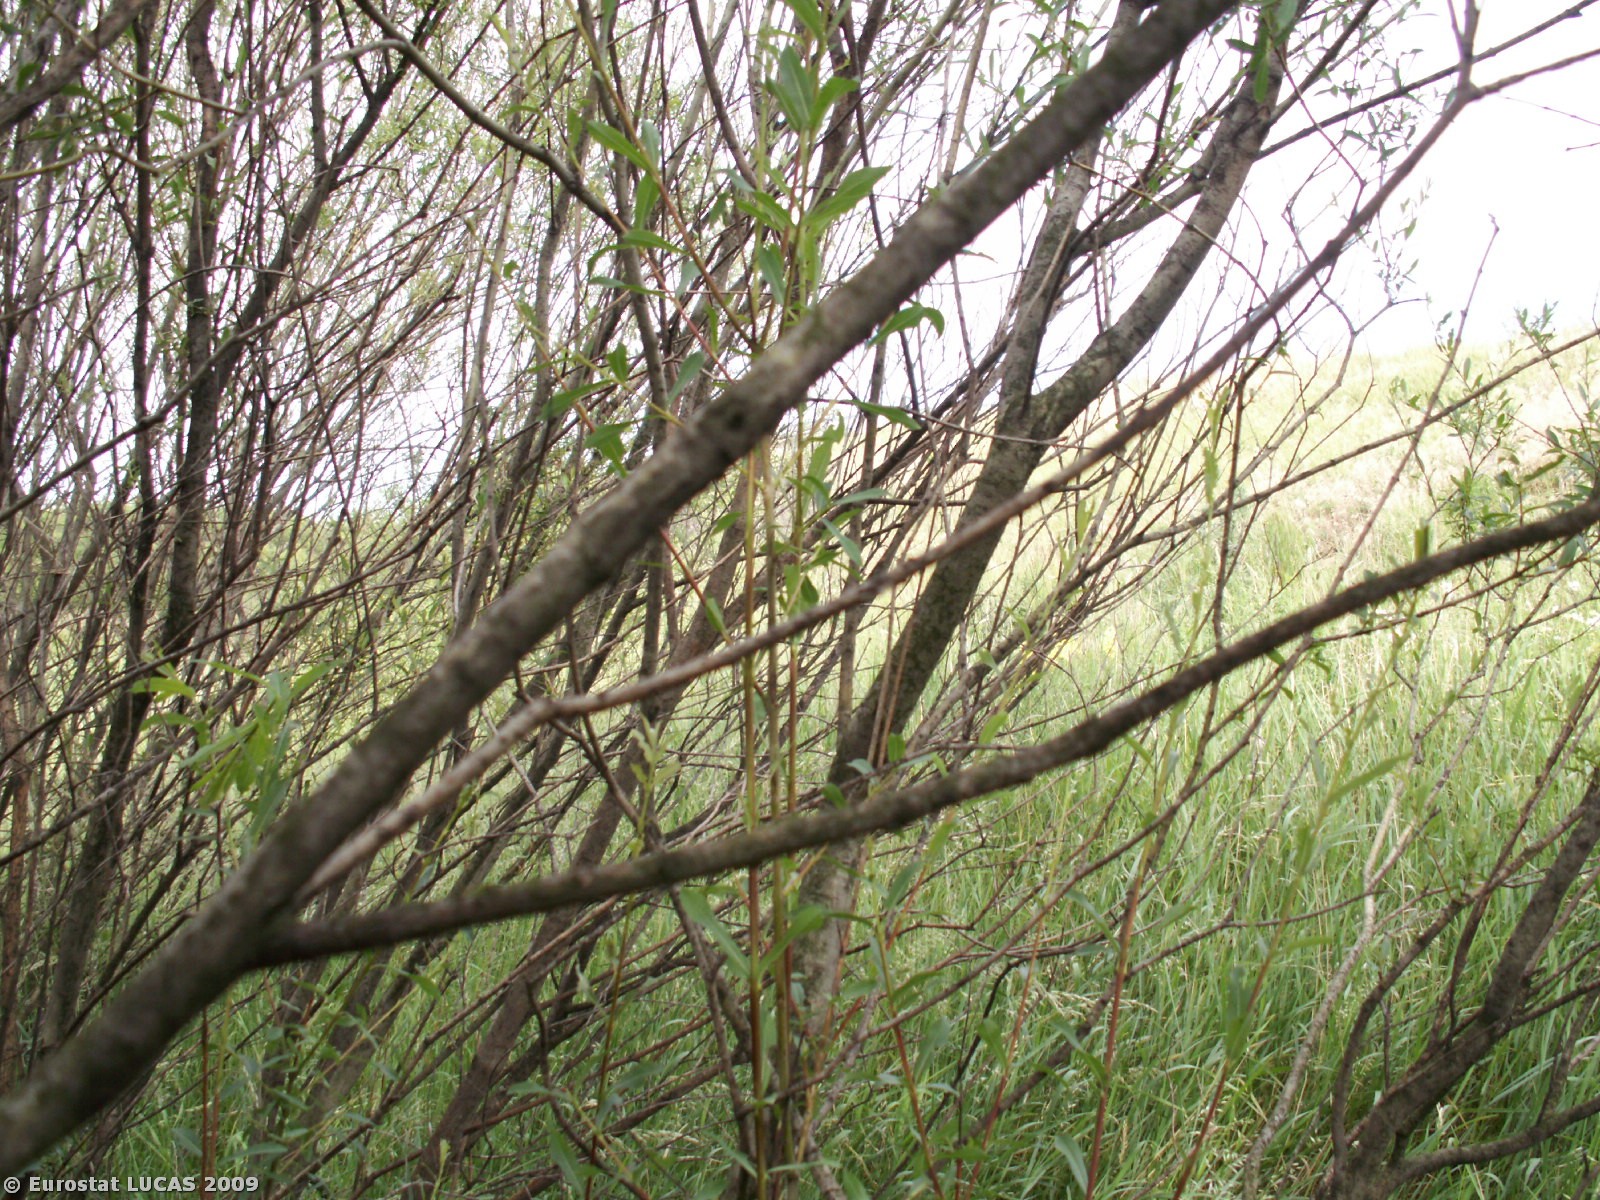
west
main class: Woodland
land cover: Broadleaved woodland
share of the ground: > 75 %
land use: Unused
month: June
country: CZ
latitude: 48.9689
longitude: 16.5227
